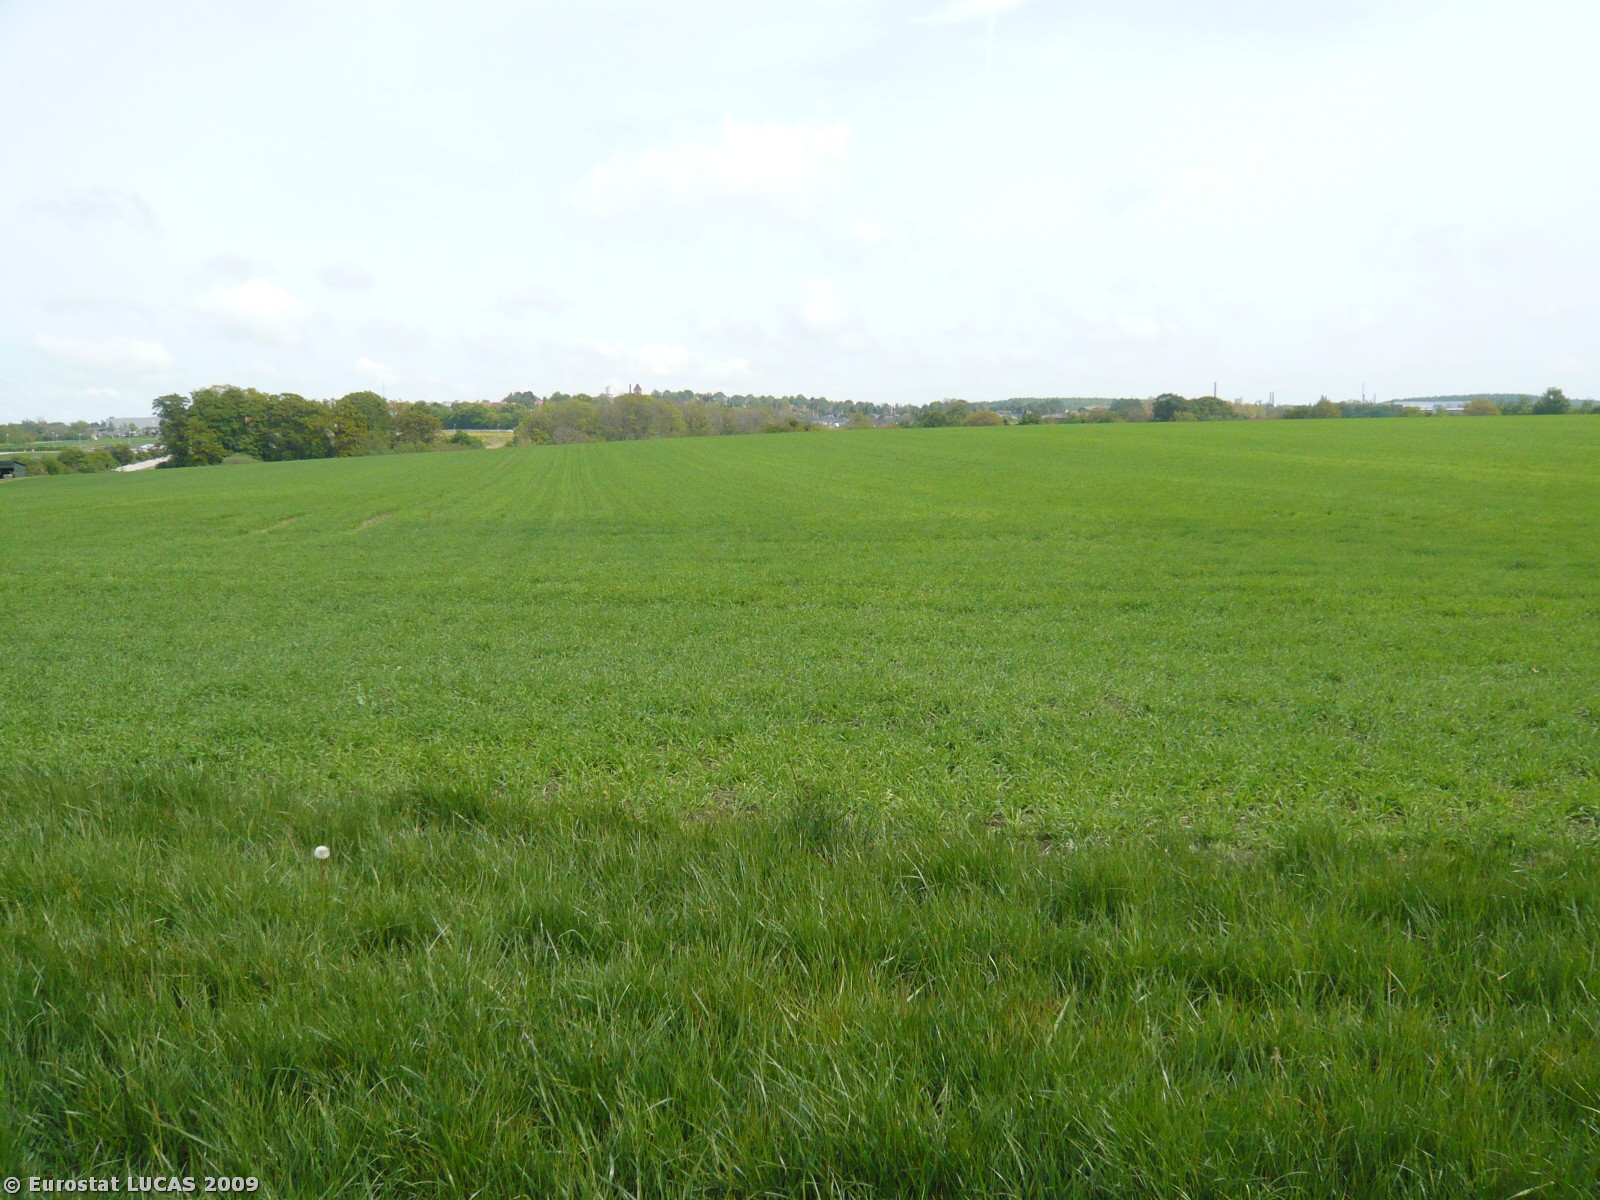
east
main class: Grassland
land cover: Grassland without tree/shrub cover
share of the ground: > 75 %
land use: Agriculture (excluding fallow land and kitchen gardens)
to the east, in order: Grassland without tree/shrub cover; Barley
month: May
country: DK
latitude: 55.2537
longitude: 12.0909
